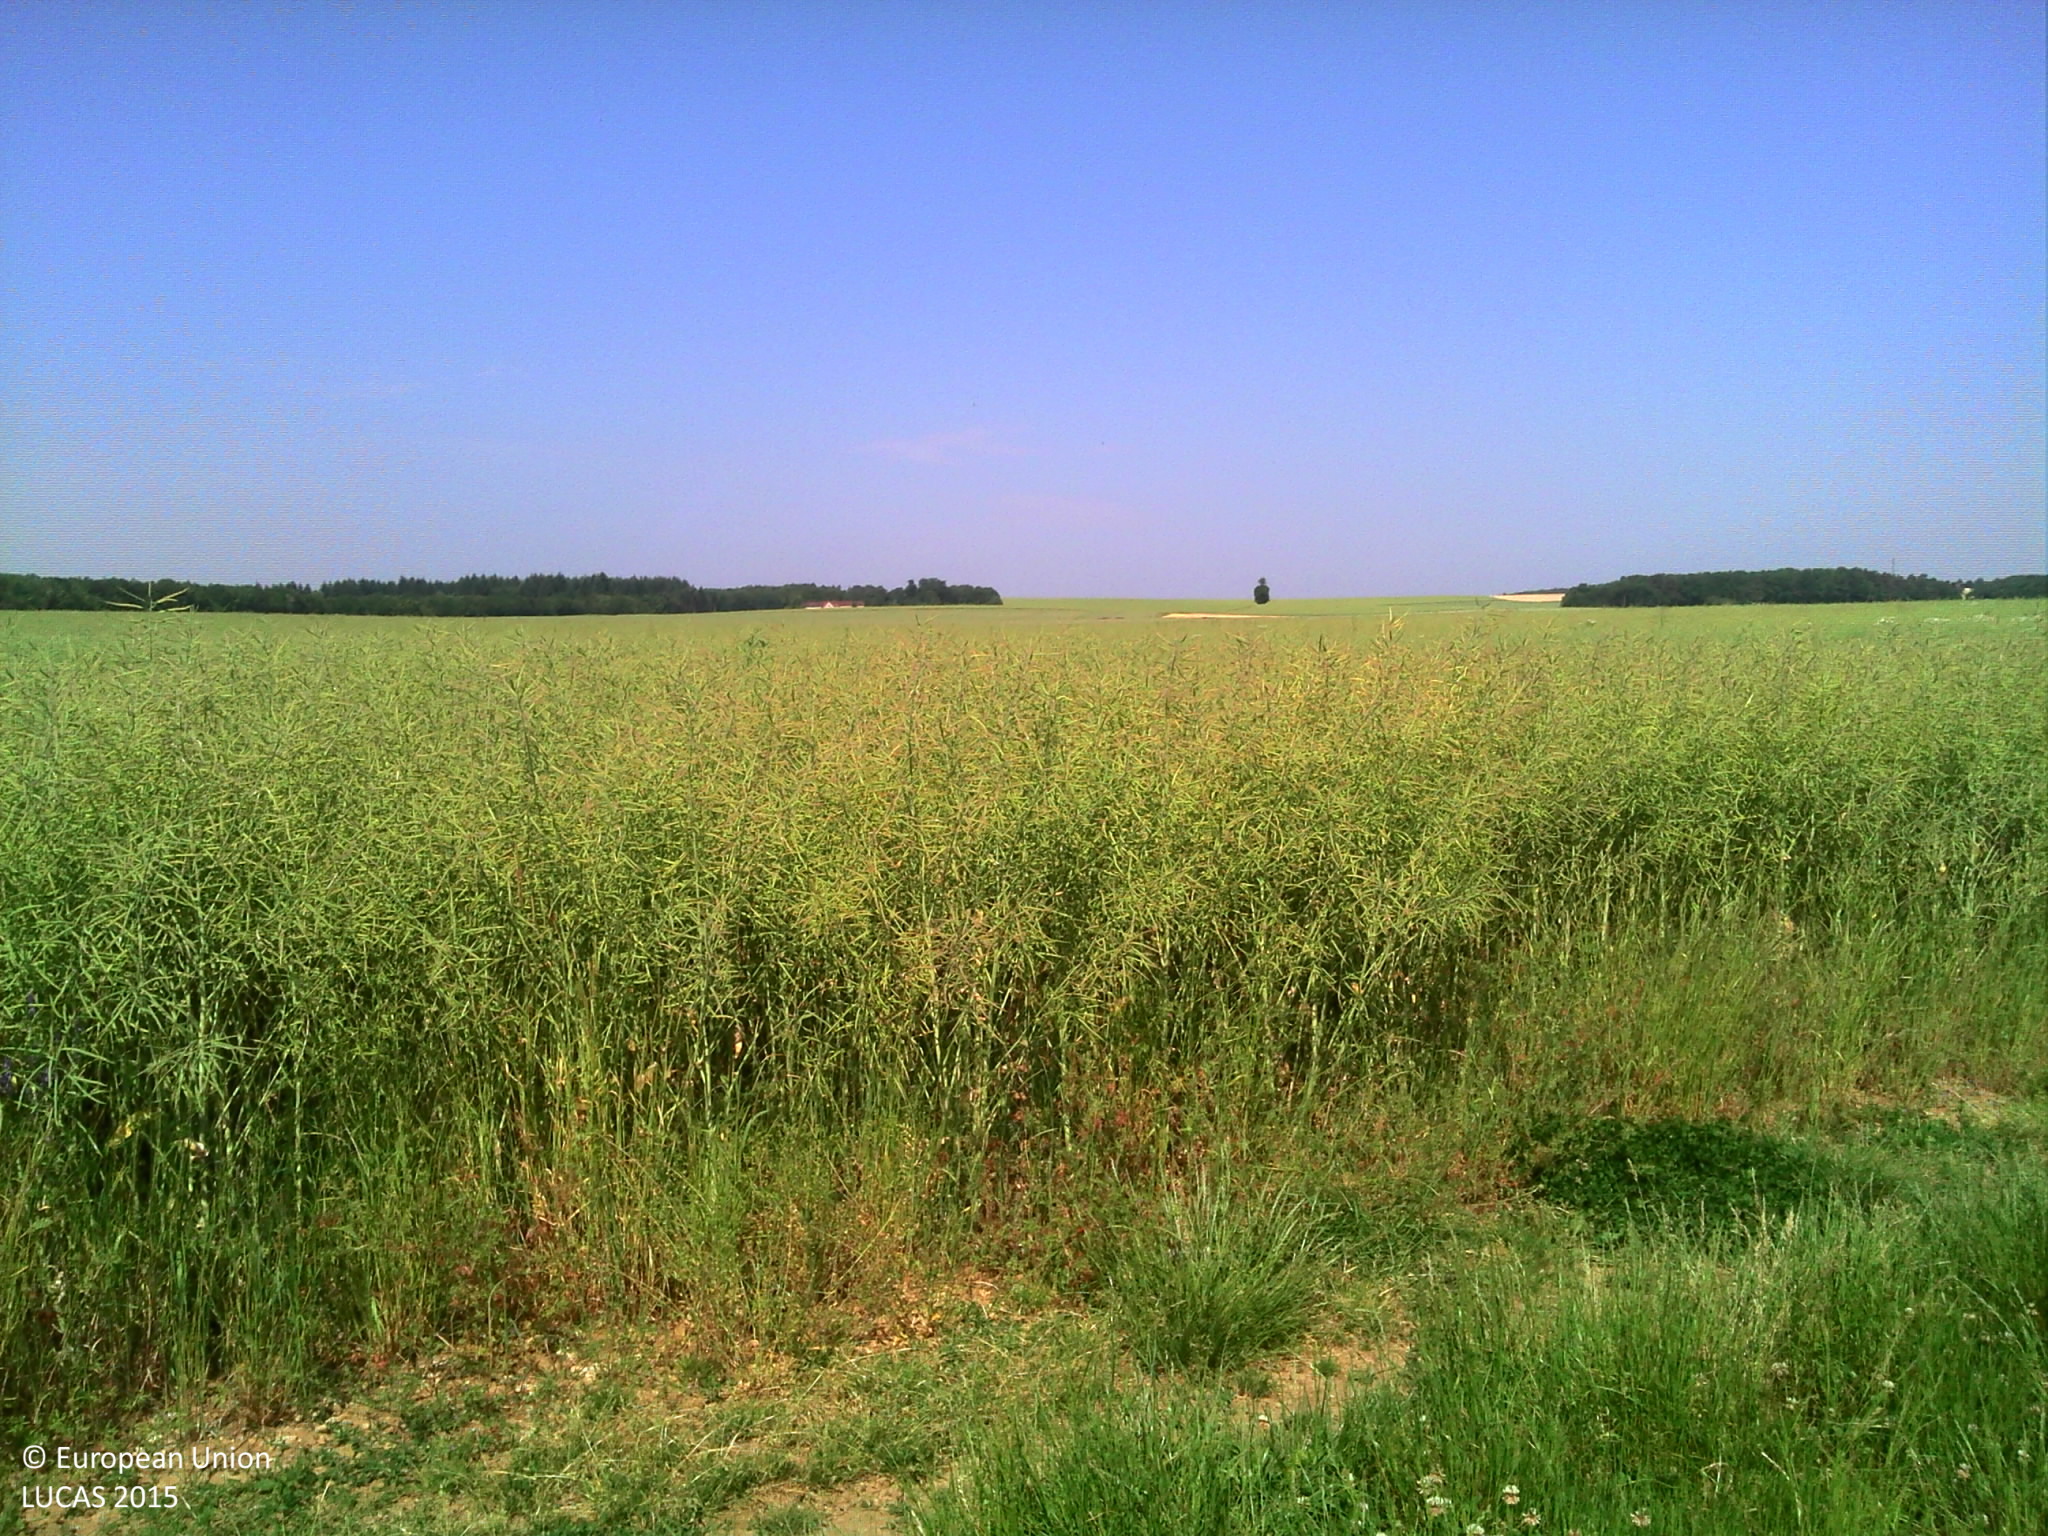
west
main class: Cropland
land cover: Rape and turnip rape
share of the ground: > 75 %
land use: Agriculture (excluding fallow land and kitchen gardens)
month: June
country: FR
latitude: 47.8398
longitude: 4.2657
